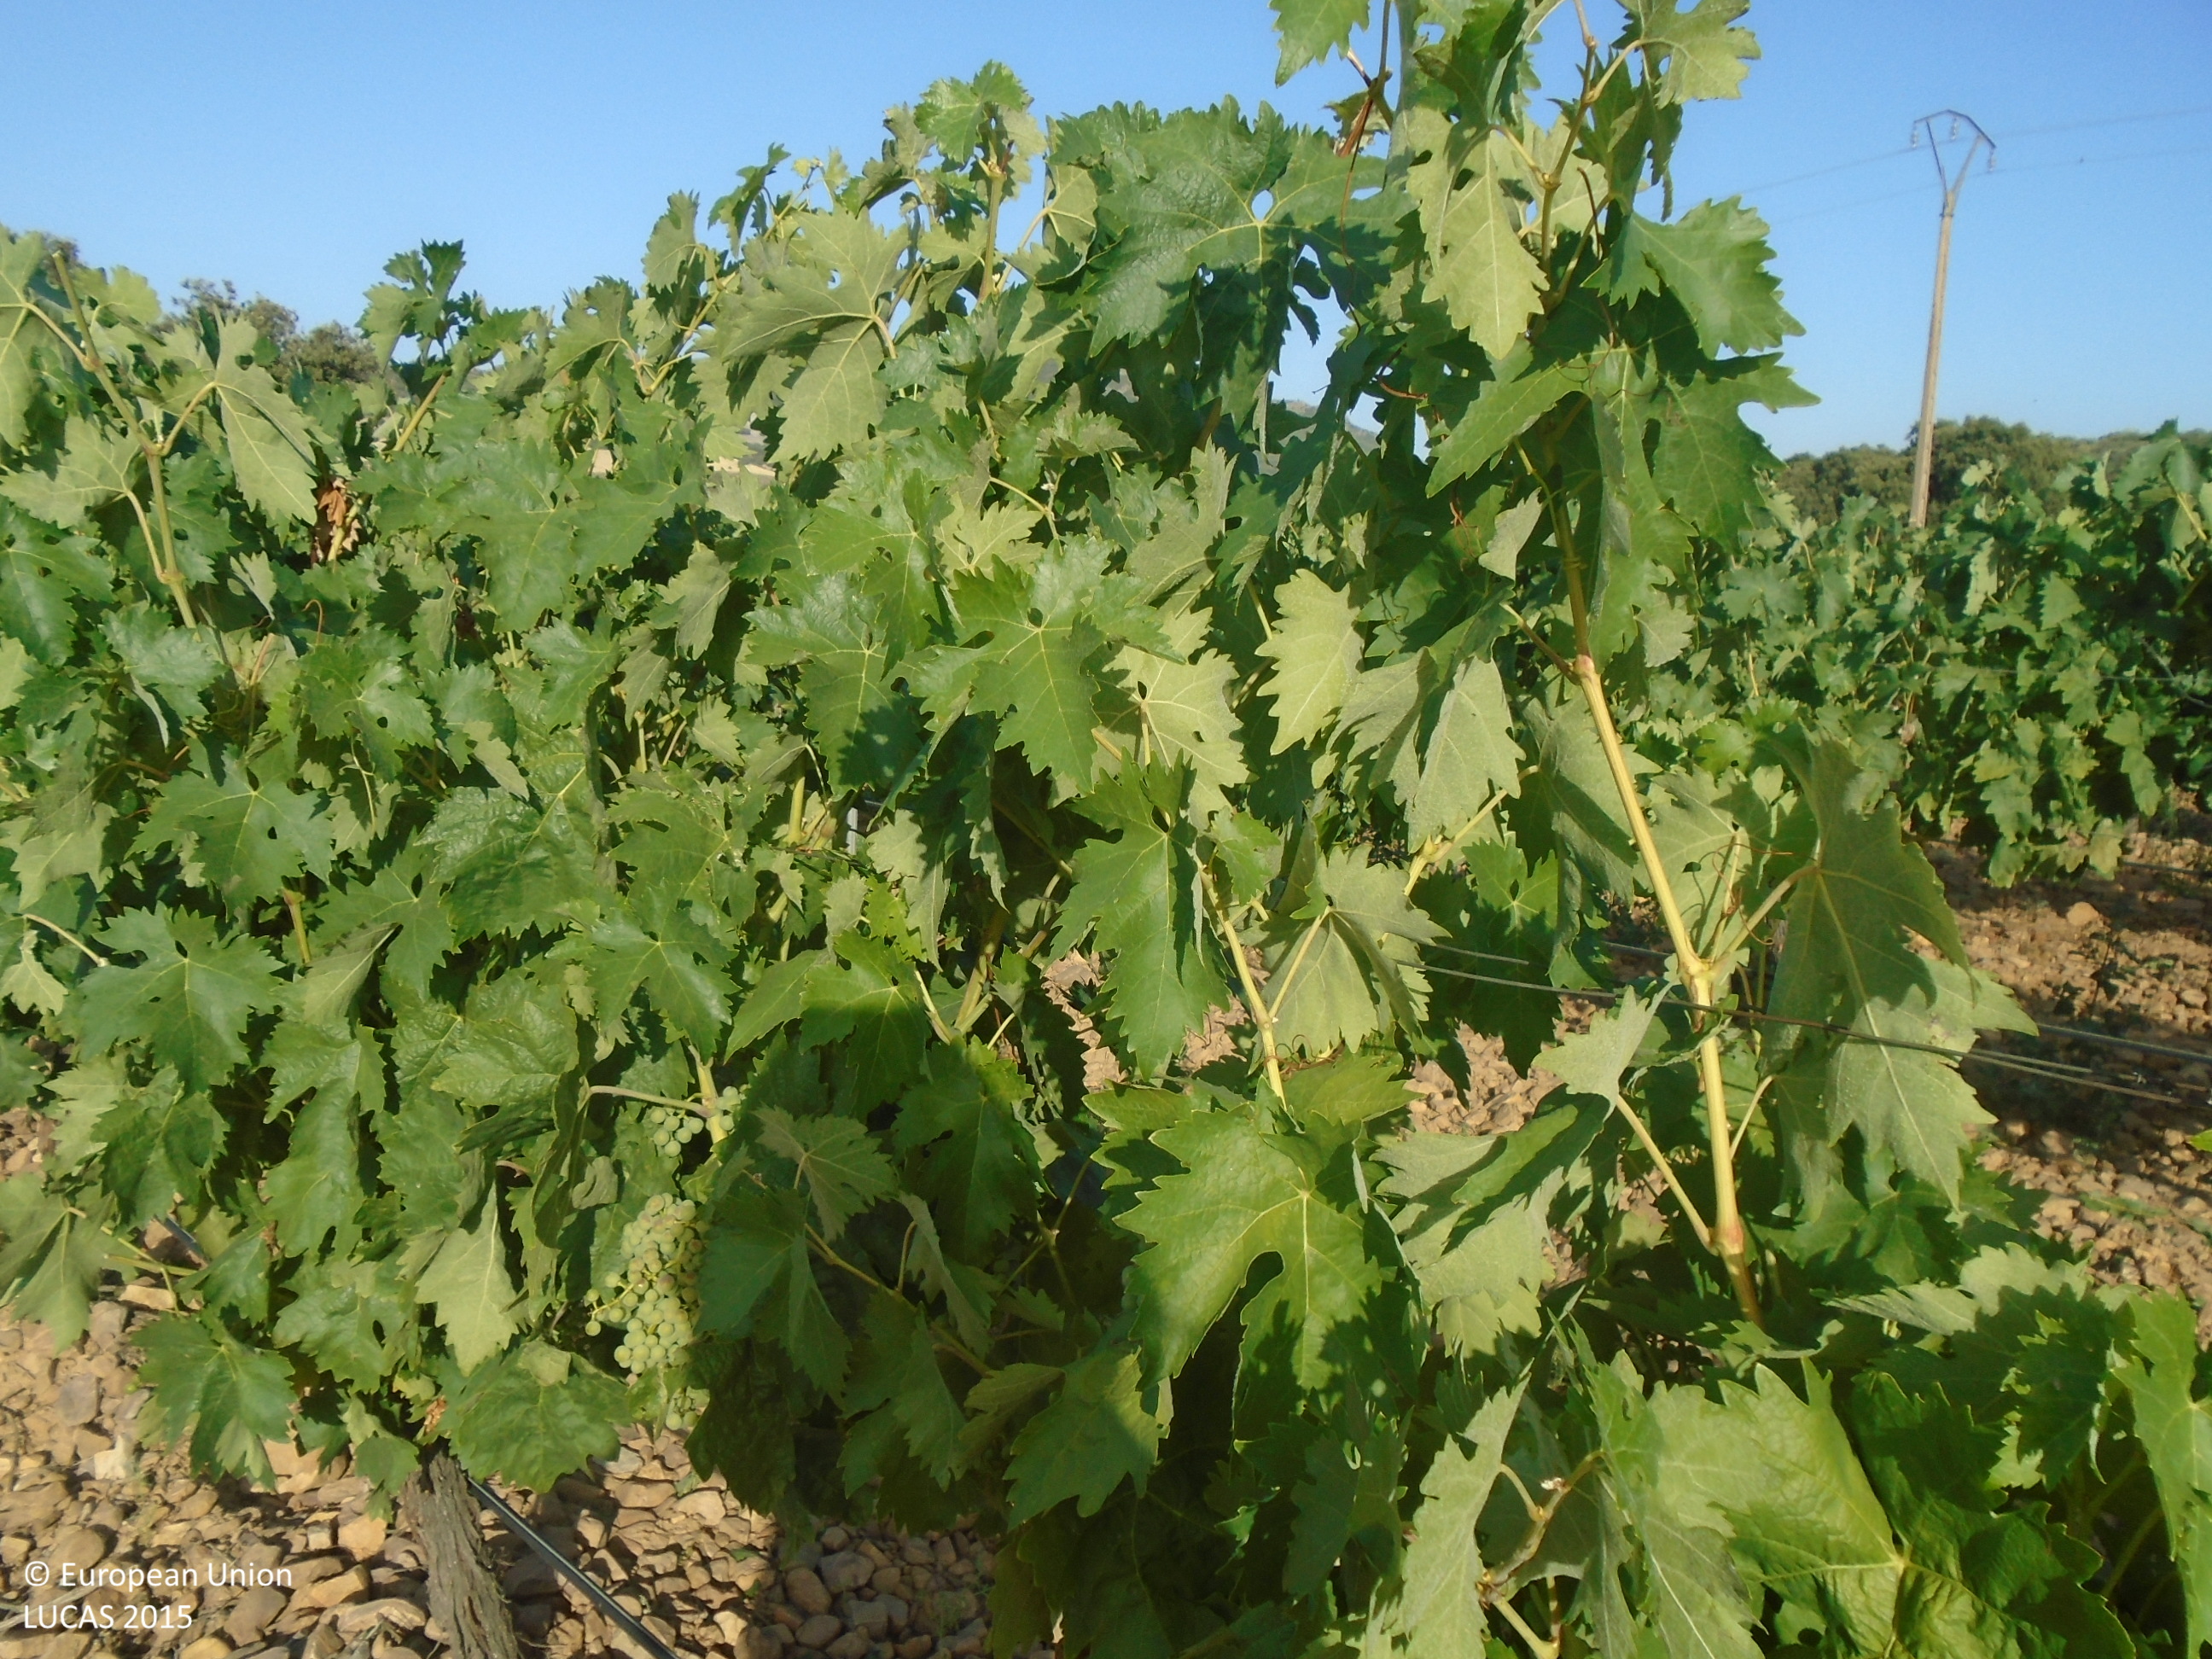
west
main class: Cropland
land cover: Vineyards
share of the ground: 10 - 25 %
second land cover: Other bare soil
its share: > 75 %
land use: Agriculture (excluding fallow land and kitchen gardens)
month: July
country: ES
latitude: 39.2783
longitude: -4.1117
